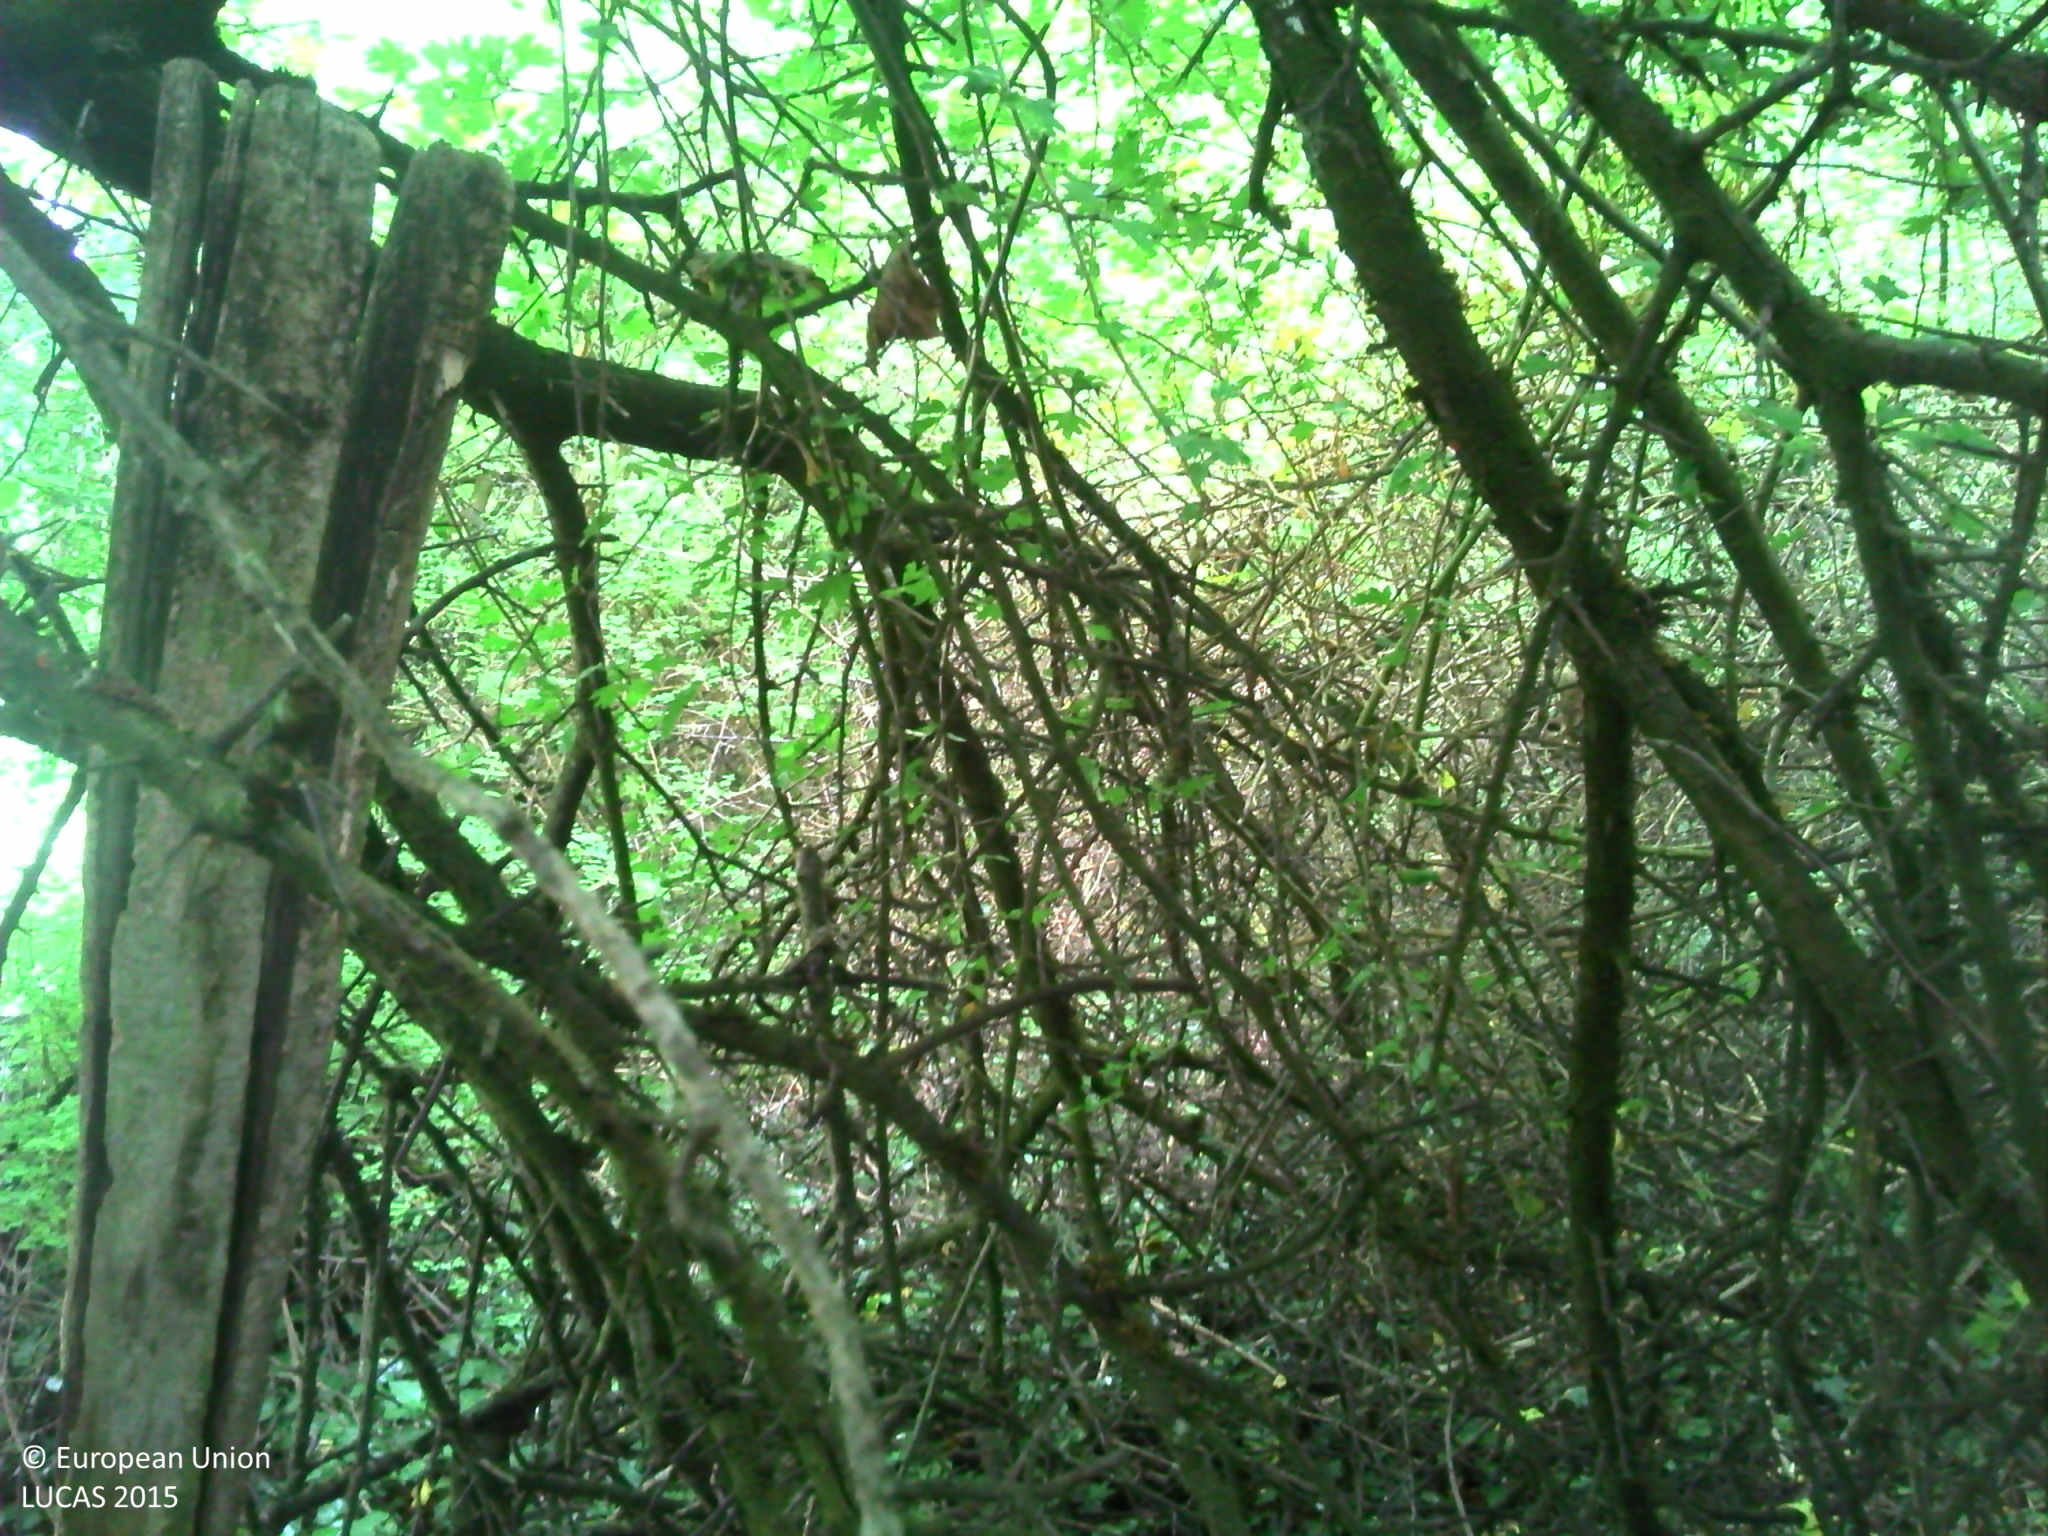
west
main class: Woodland
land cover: Broadleaved woodland
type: mesophytic deciduous forest
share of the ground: > 75 %
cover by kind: broadleaved forest trees 100 %
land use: Forestry
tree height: > 5 m
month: June
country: FR
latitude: 47.4903
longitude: 7.3870
